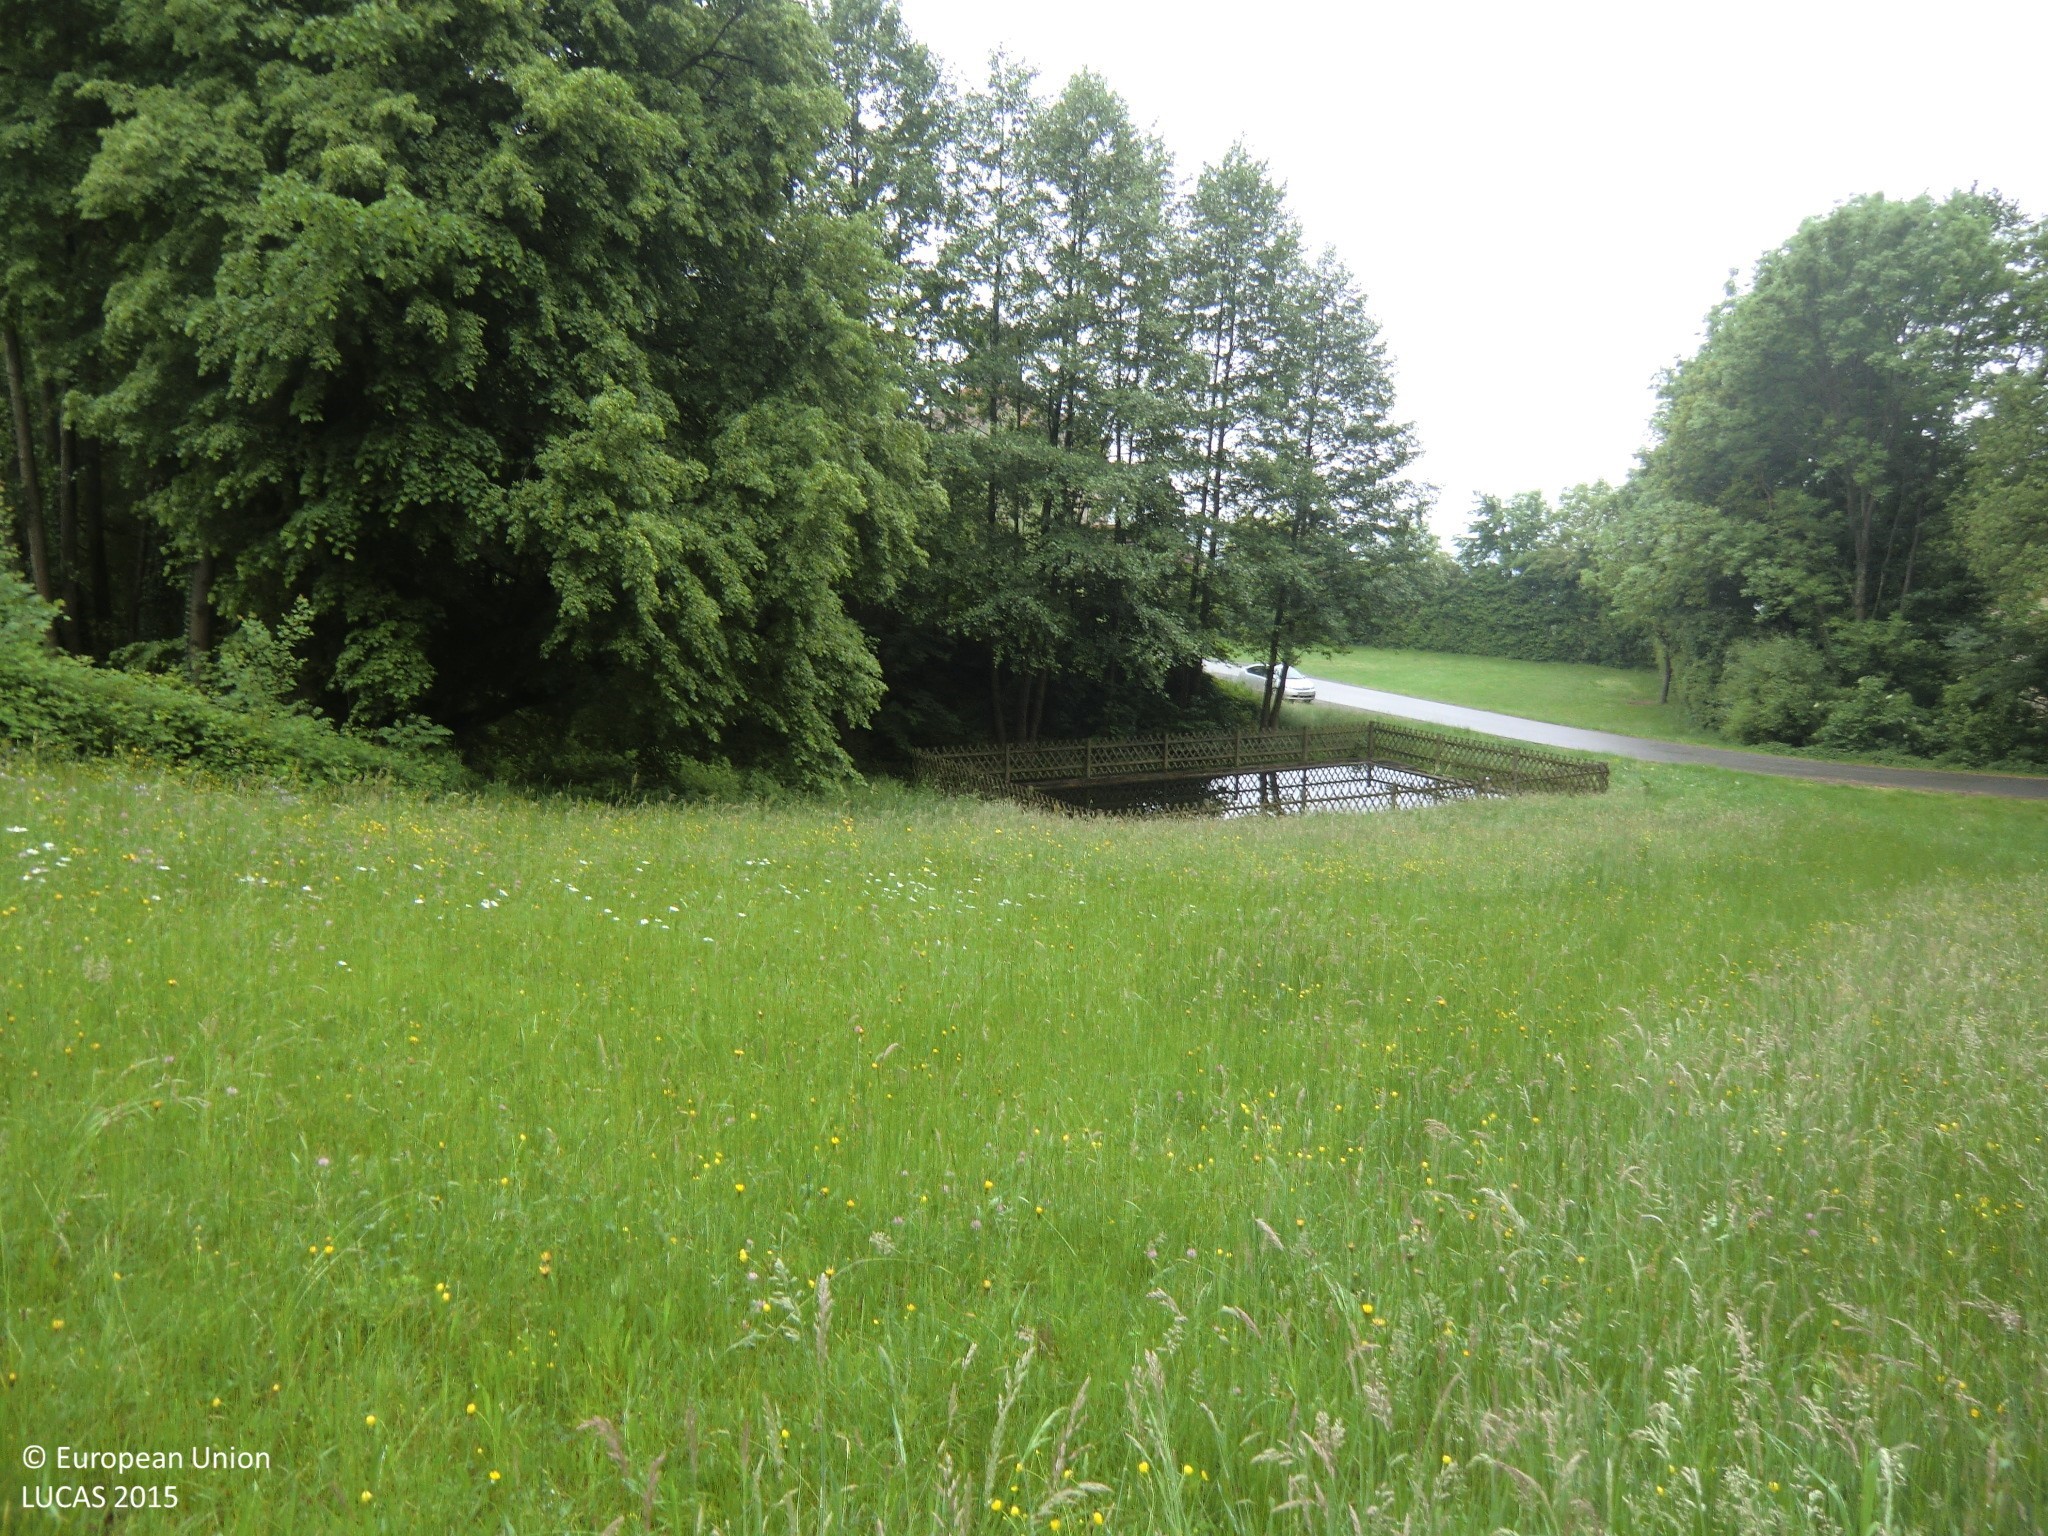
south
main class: Grassland
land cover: Grassland without tree/shrub cover
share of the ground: > 75 %
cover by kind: herbaceous plants 100 %
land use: Agriculture (excluding fallow land and kitchen gardens)
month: May
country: AT
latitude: 47.2875
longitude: 15.9383
